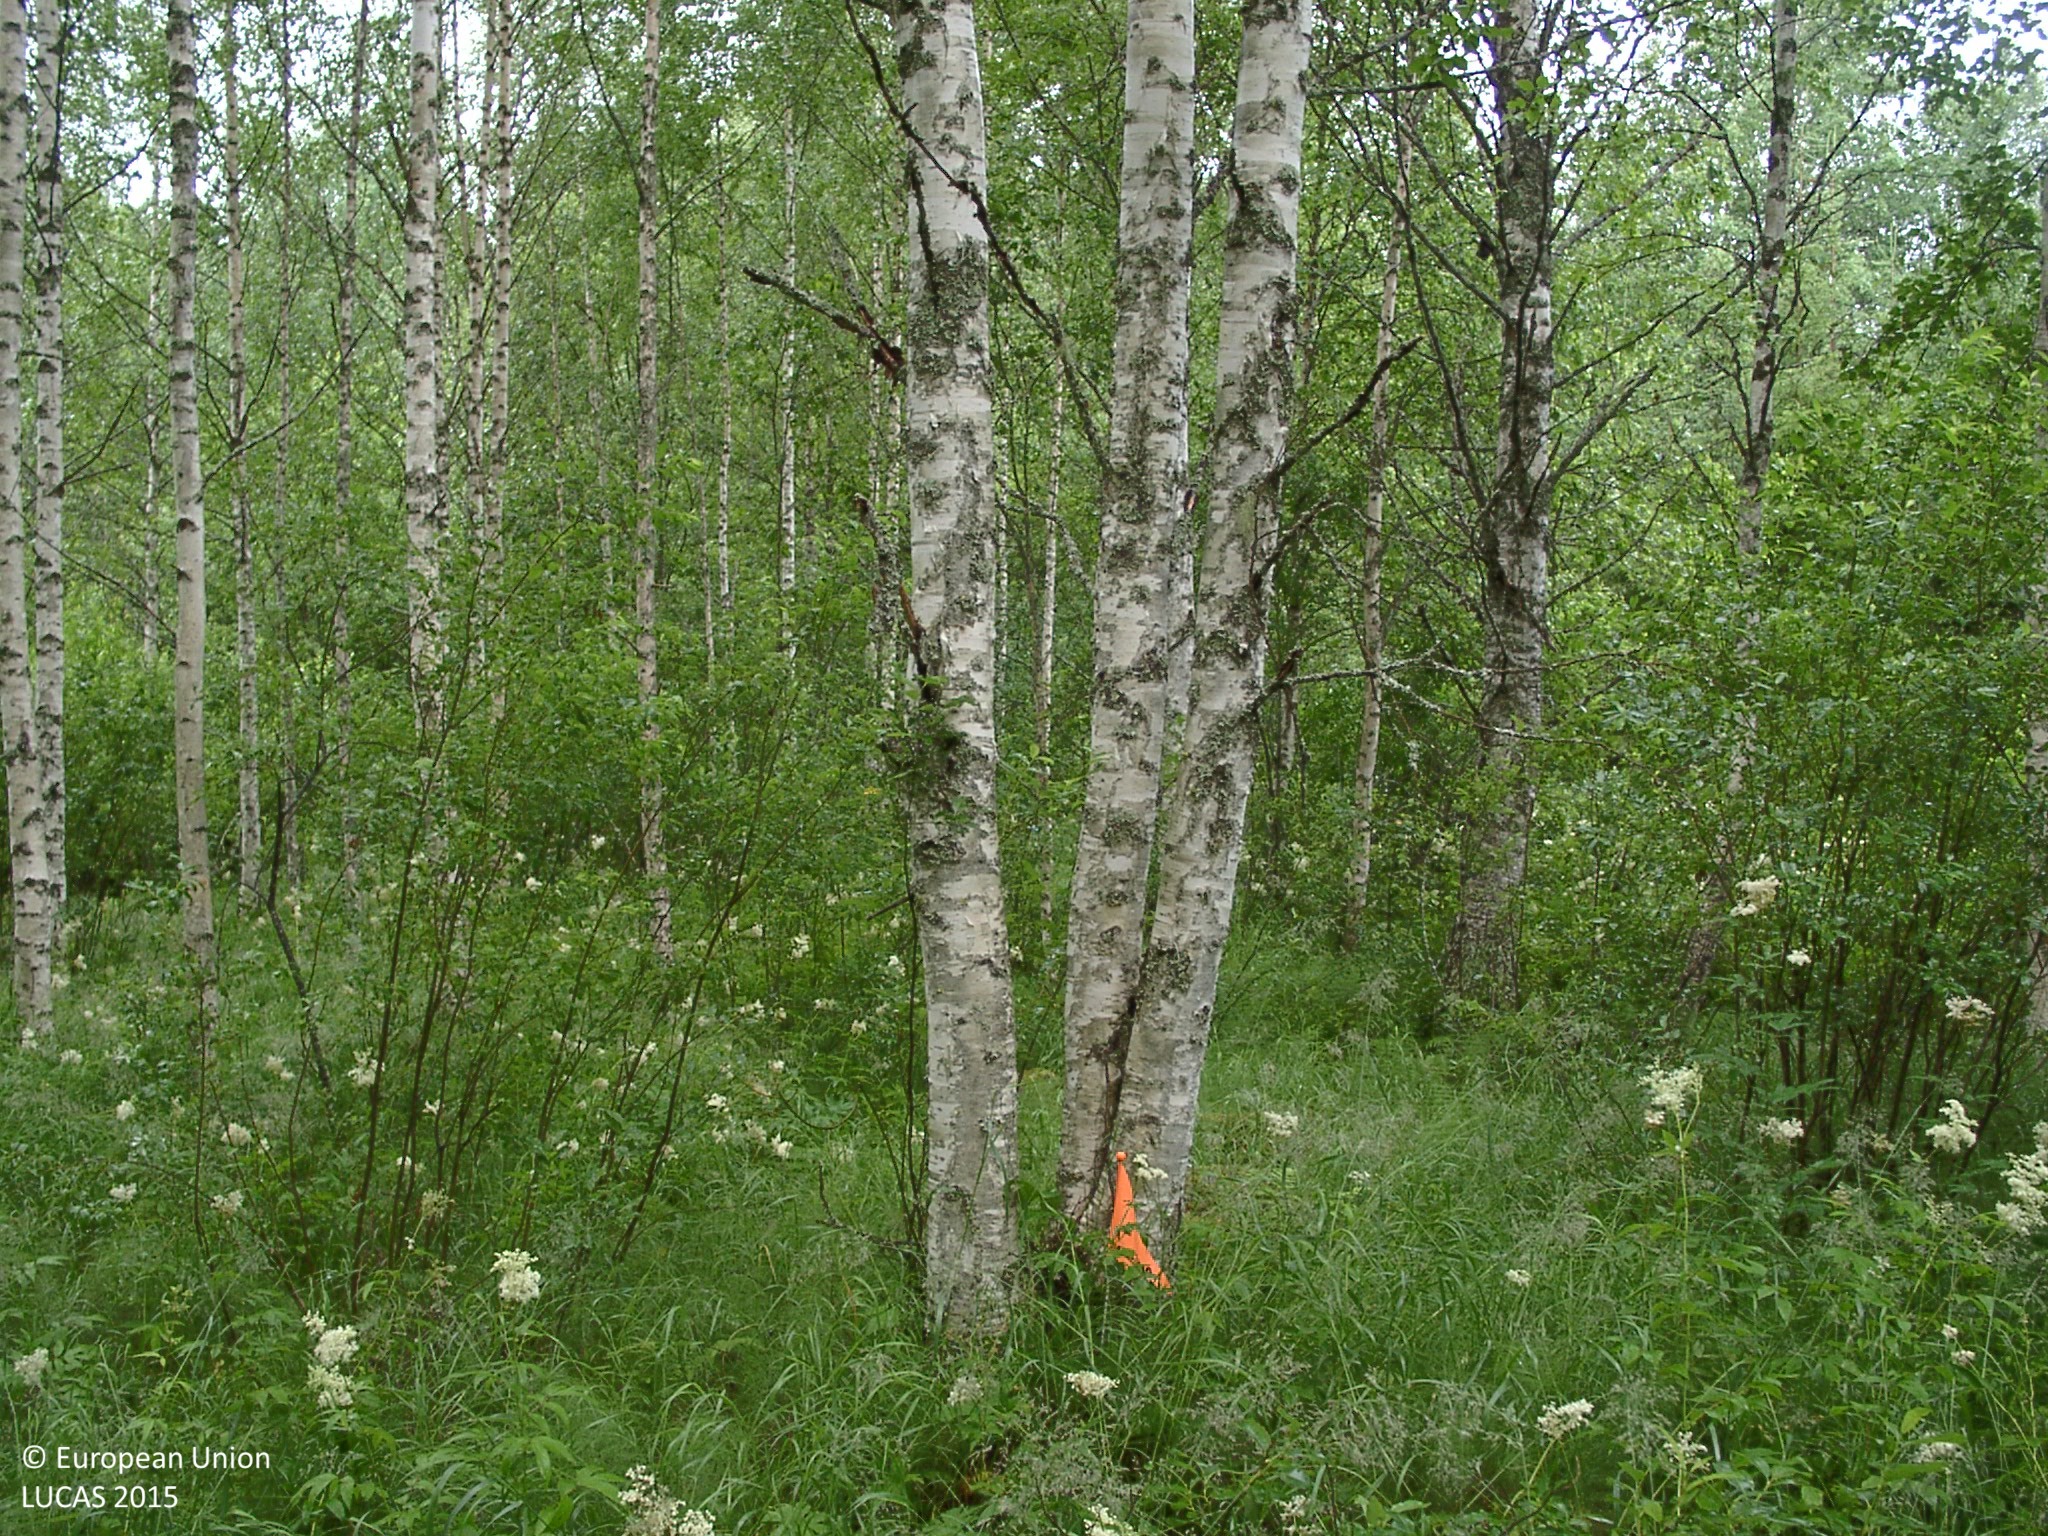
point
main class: Woodland
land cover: Broadleaved woodland
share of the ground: 50 - 75 %
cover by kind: broadleaved forest trees 60 %, herbaceous plants 30 %, shrubs 10 %
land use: Semi-natural and natural areas not in use
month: July
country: FI
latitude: 62.2512
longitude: 25.6152
